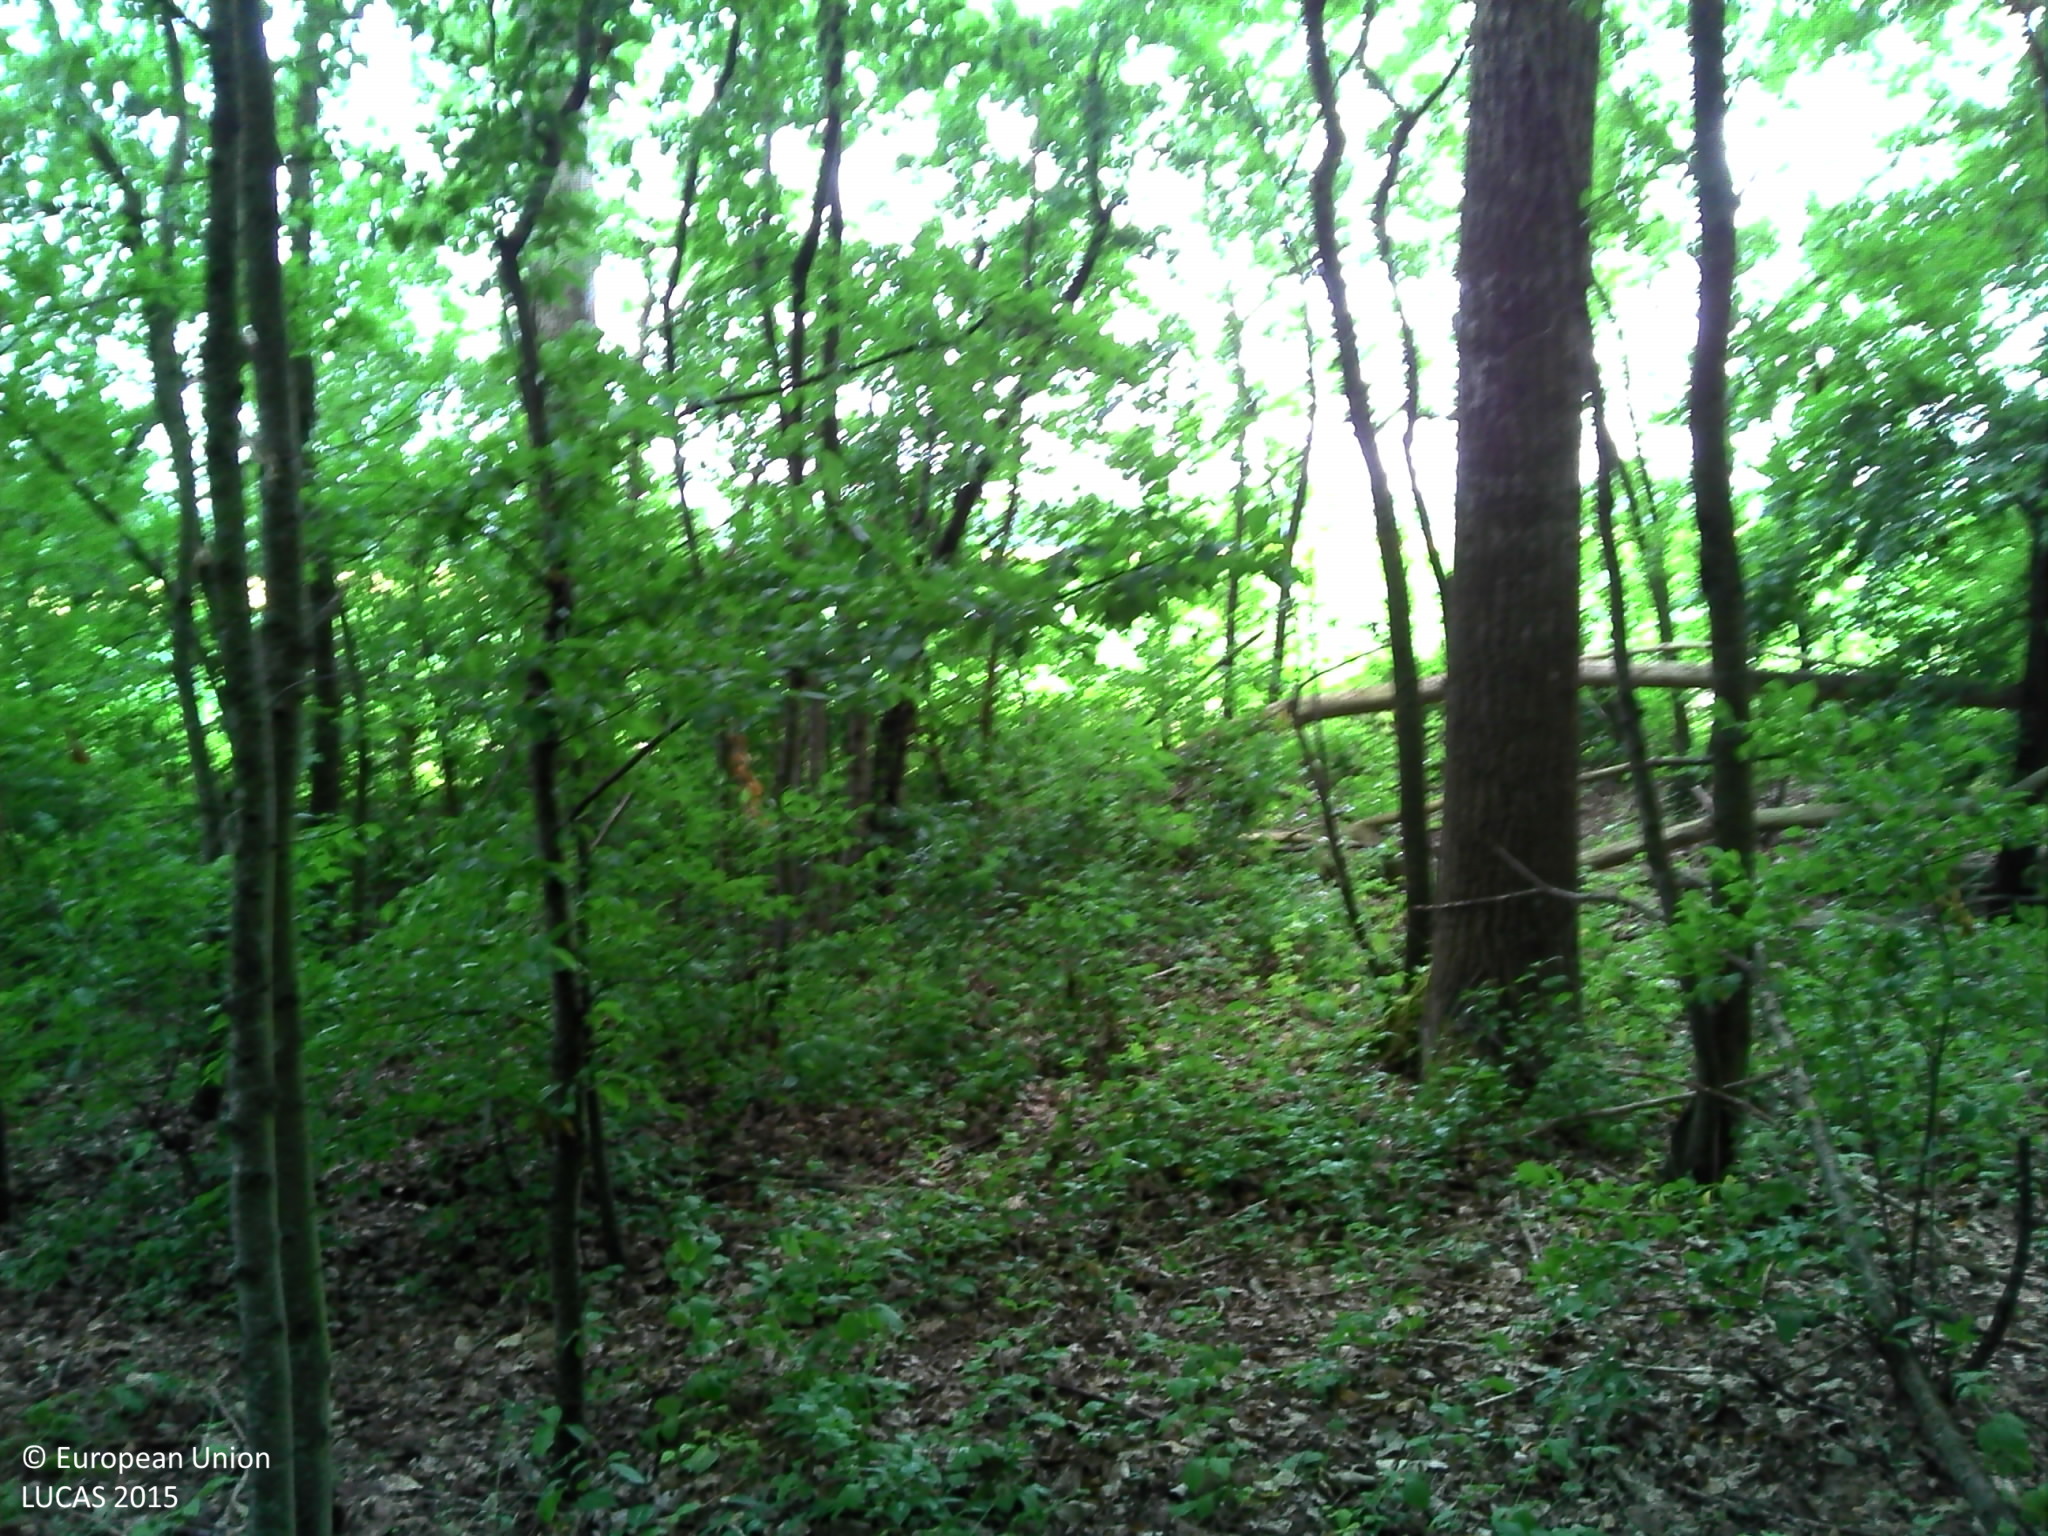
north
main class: Woodland
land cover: Broadleaved woodland
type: exotic forest
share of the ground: > 75 %
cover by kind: broadleaved forest trees 100 %
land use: Forestry
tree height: > 5 m
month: July
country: BE
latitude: 50.4236
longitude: 4.0122
